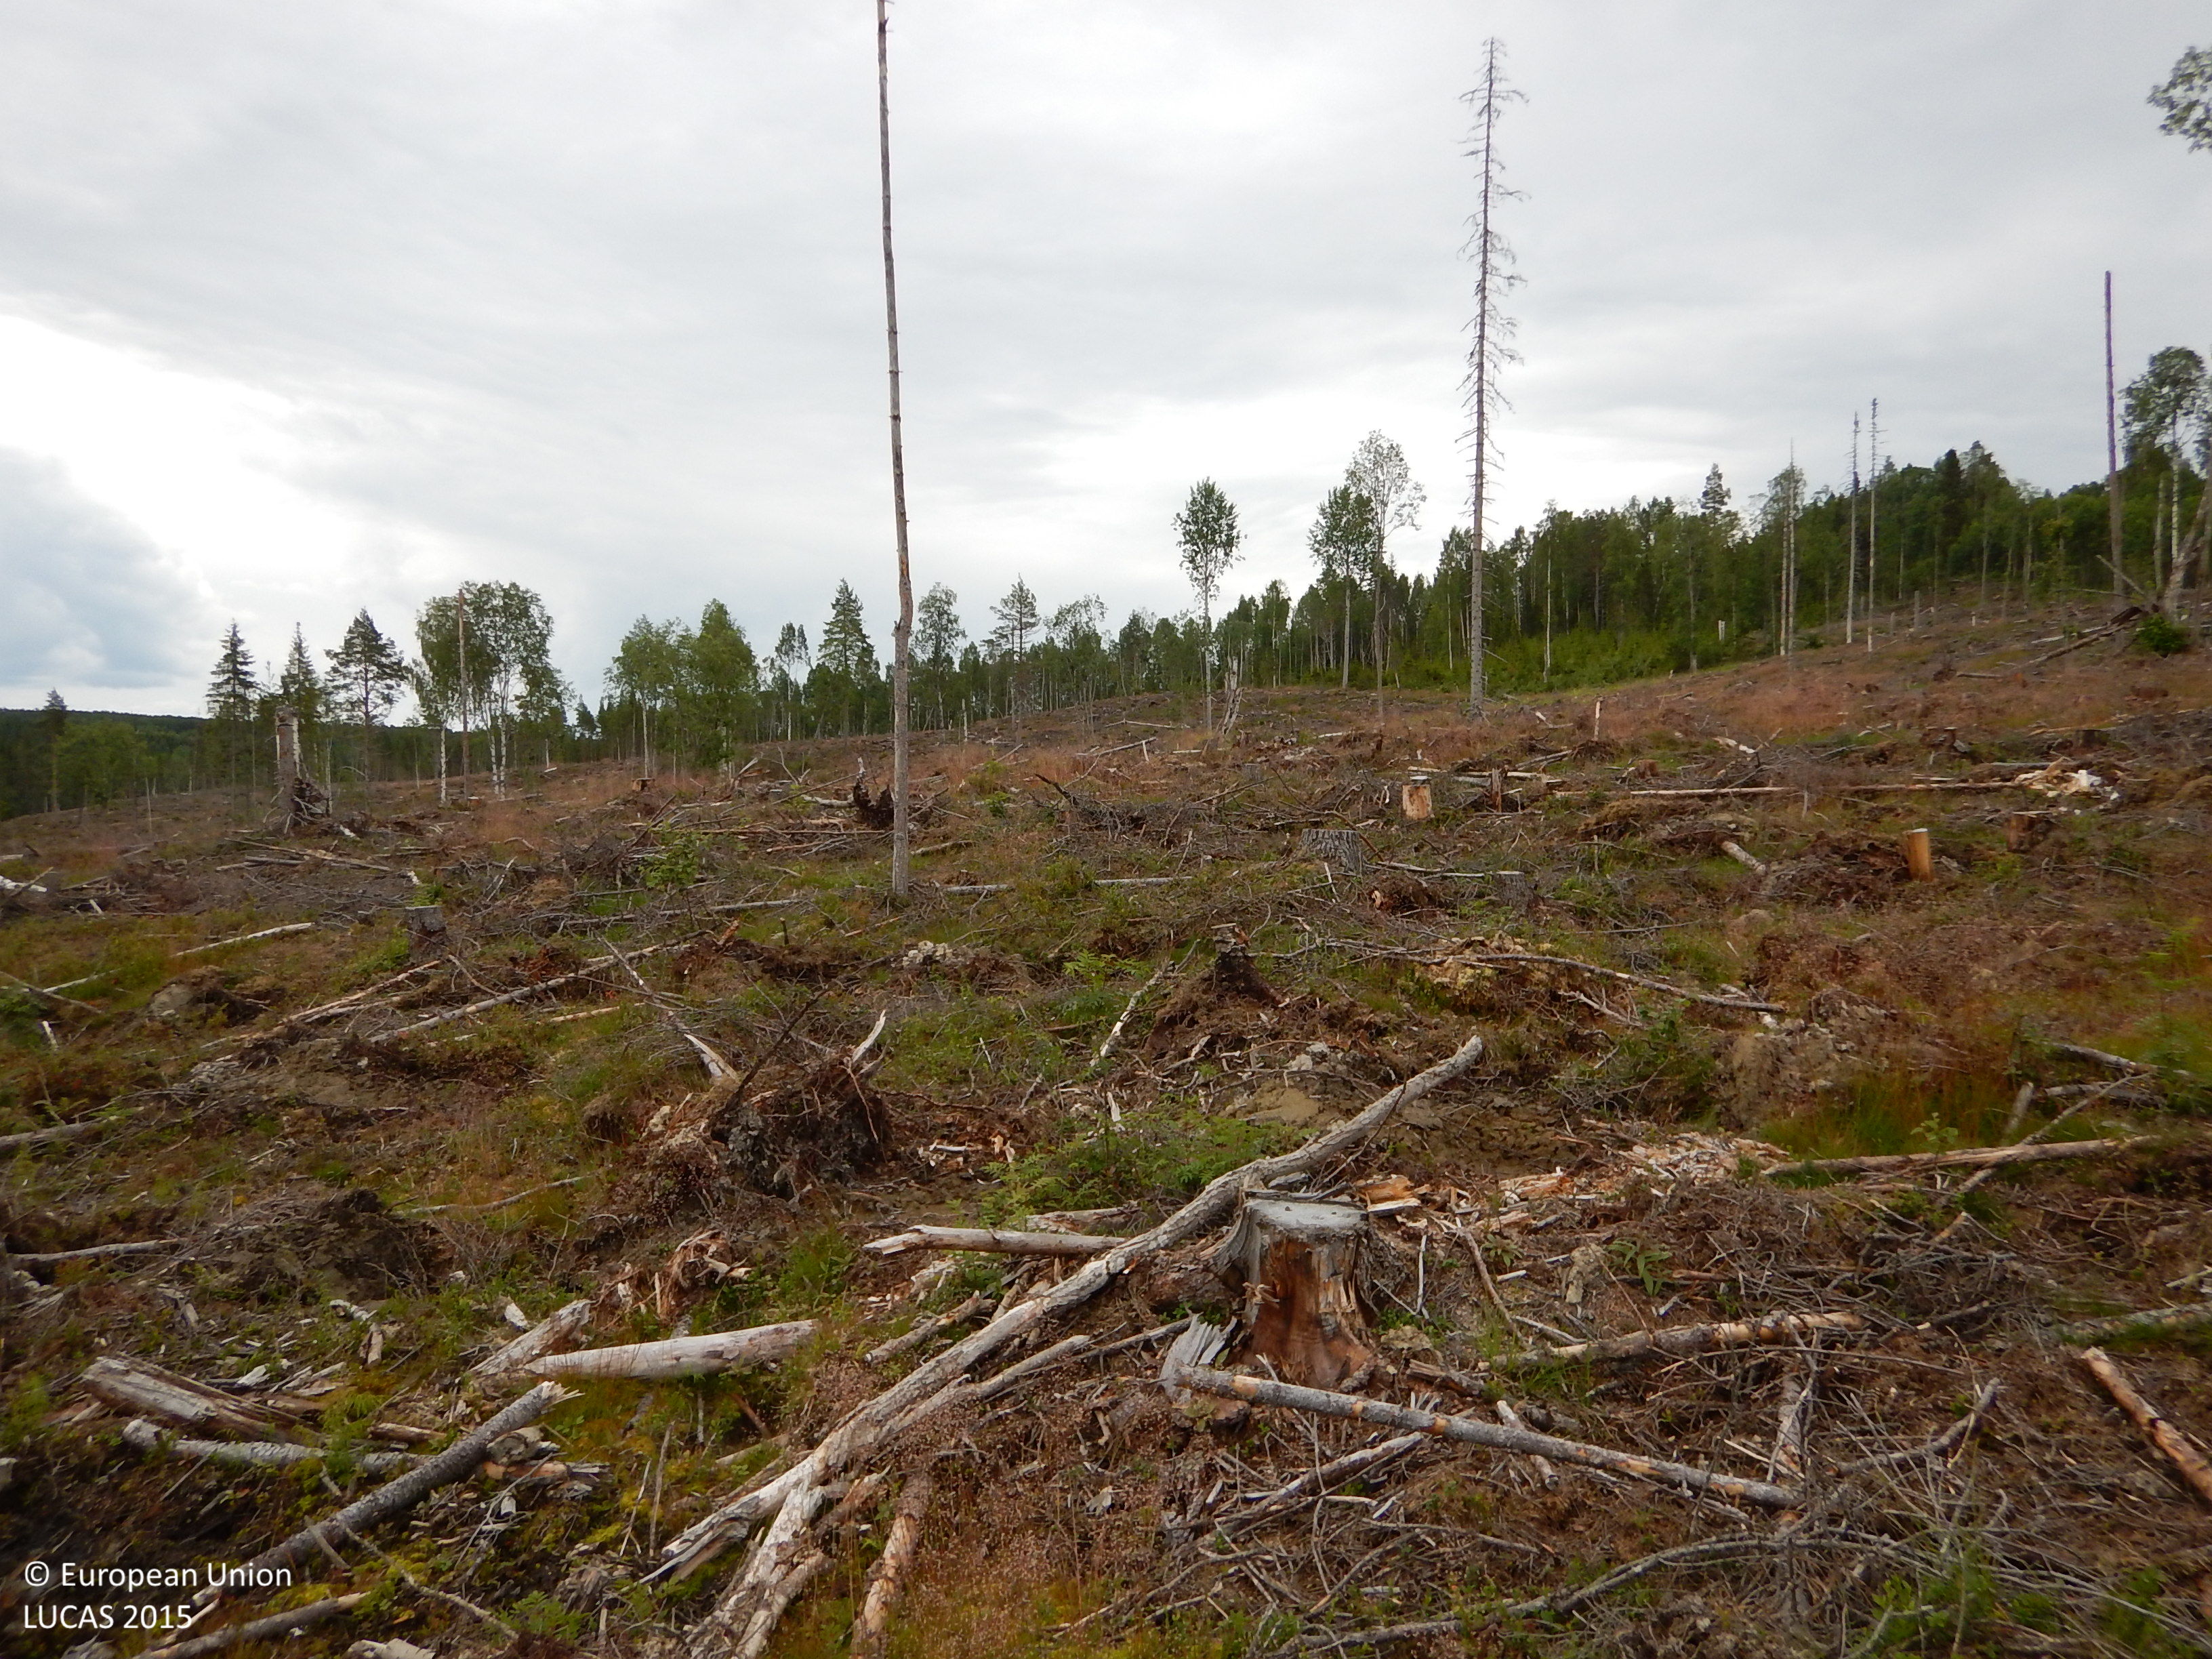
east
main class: Grassland
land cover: Grassland without tree/shrub cover
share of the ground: 25 - 50 %
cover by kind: unconsolidated bare surface 35 %, herbaceous plants 30 %, lichens and mosses 20 %, consolidated bare surface 10 %, shrubs 5 %
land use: Forestry
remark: Clear cut
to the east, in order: Grassland without tree/shrub cover; Broadleaved woodland; Grassland without tree/shrub cover
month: July
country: SE
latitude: 64.9470
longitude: 20.4490
